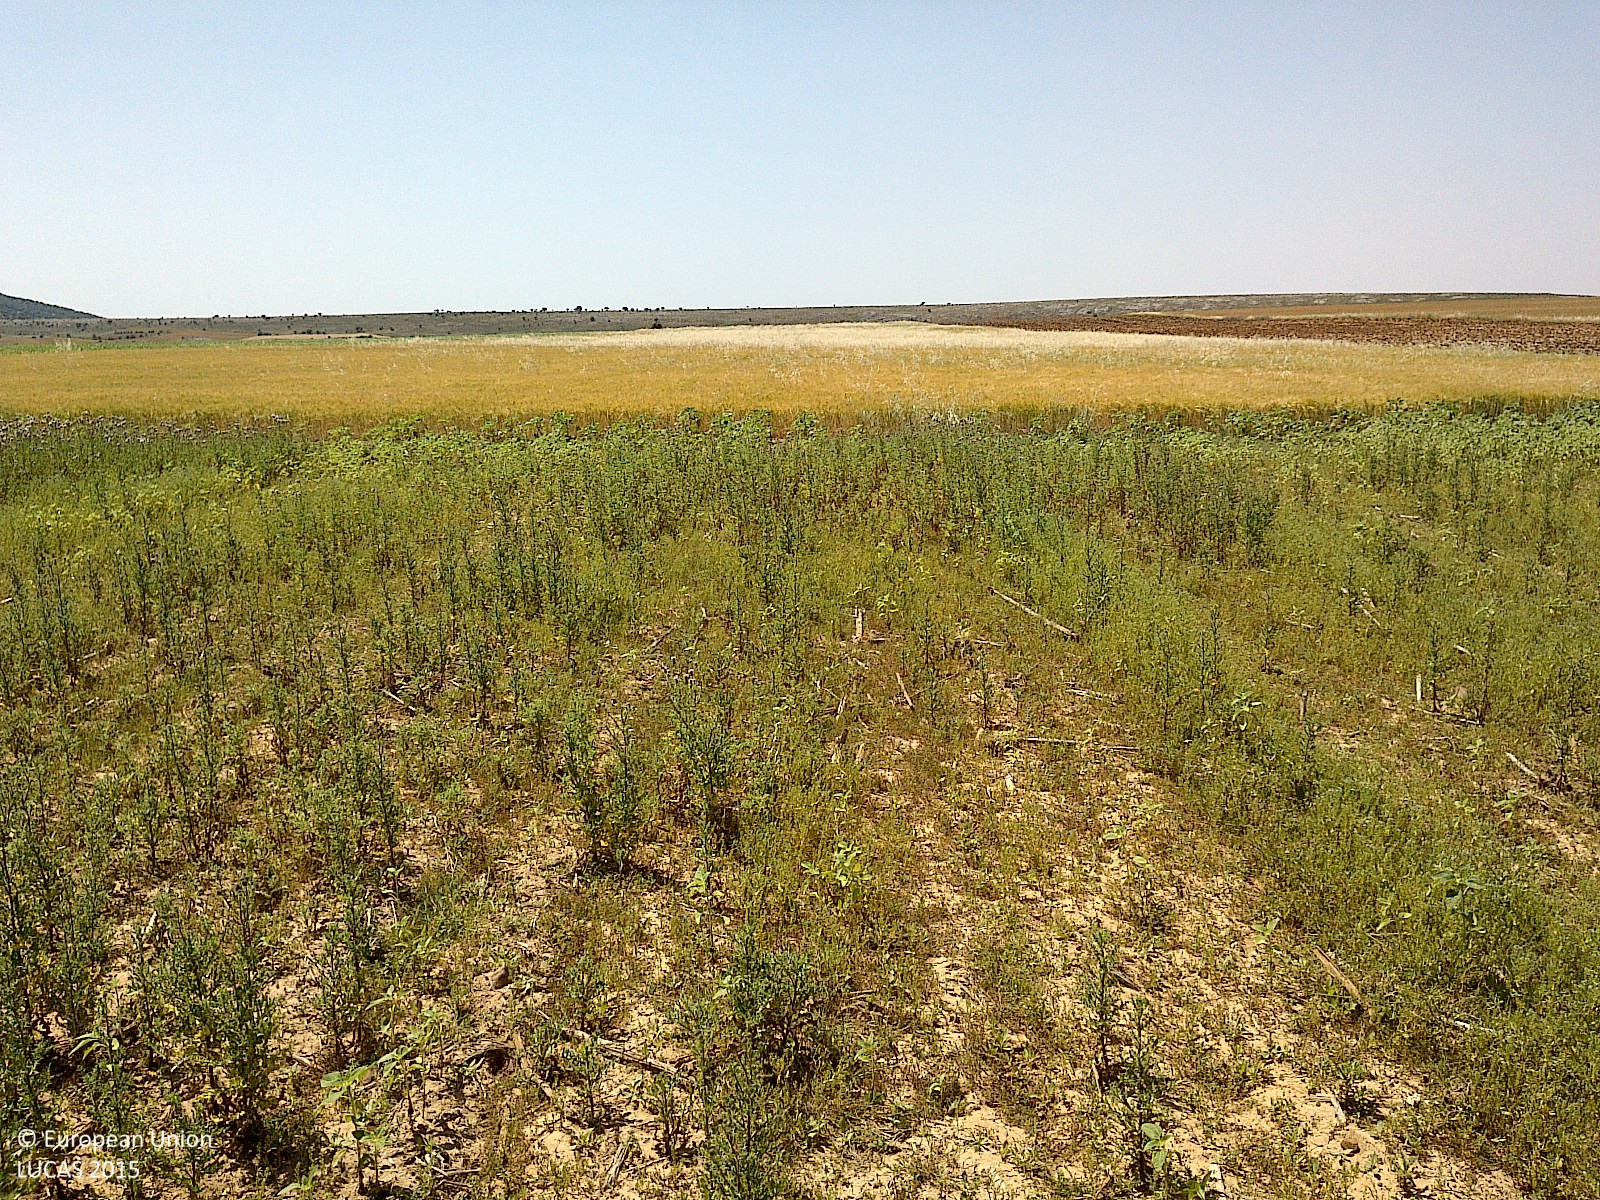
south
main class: Grassland
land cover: Spontaneously vegetated surfaces
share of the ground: > 75 %
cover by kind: herbaceous plants 75 %, unconsolidated bare surface 25 %
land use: Fallow land
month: July
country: ES
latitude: 41.5779
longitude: -2.1099
